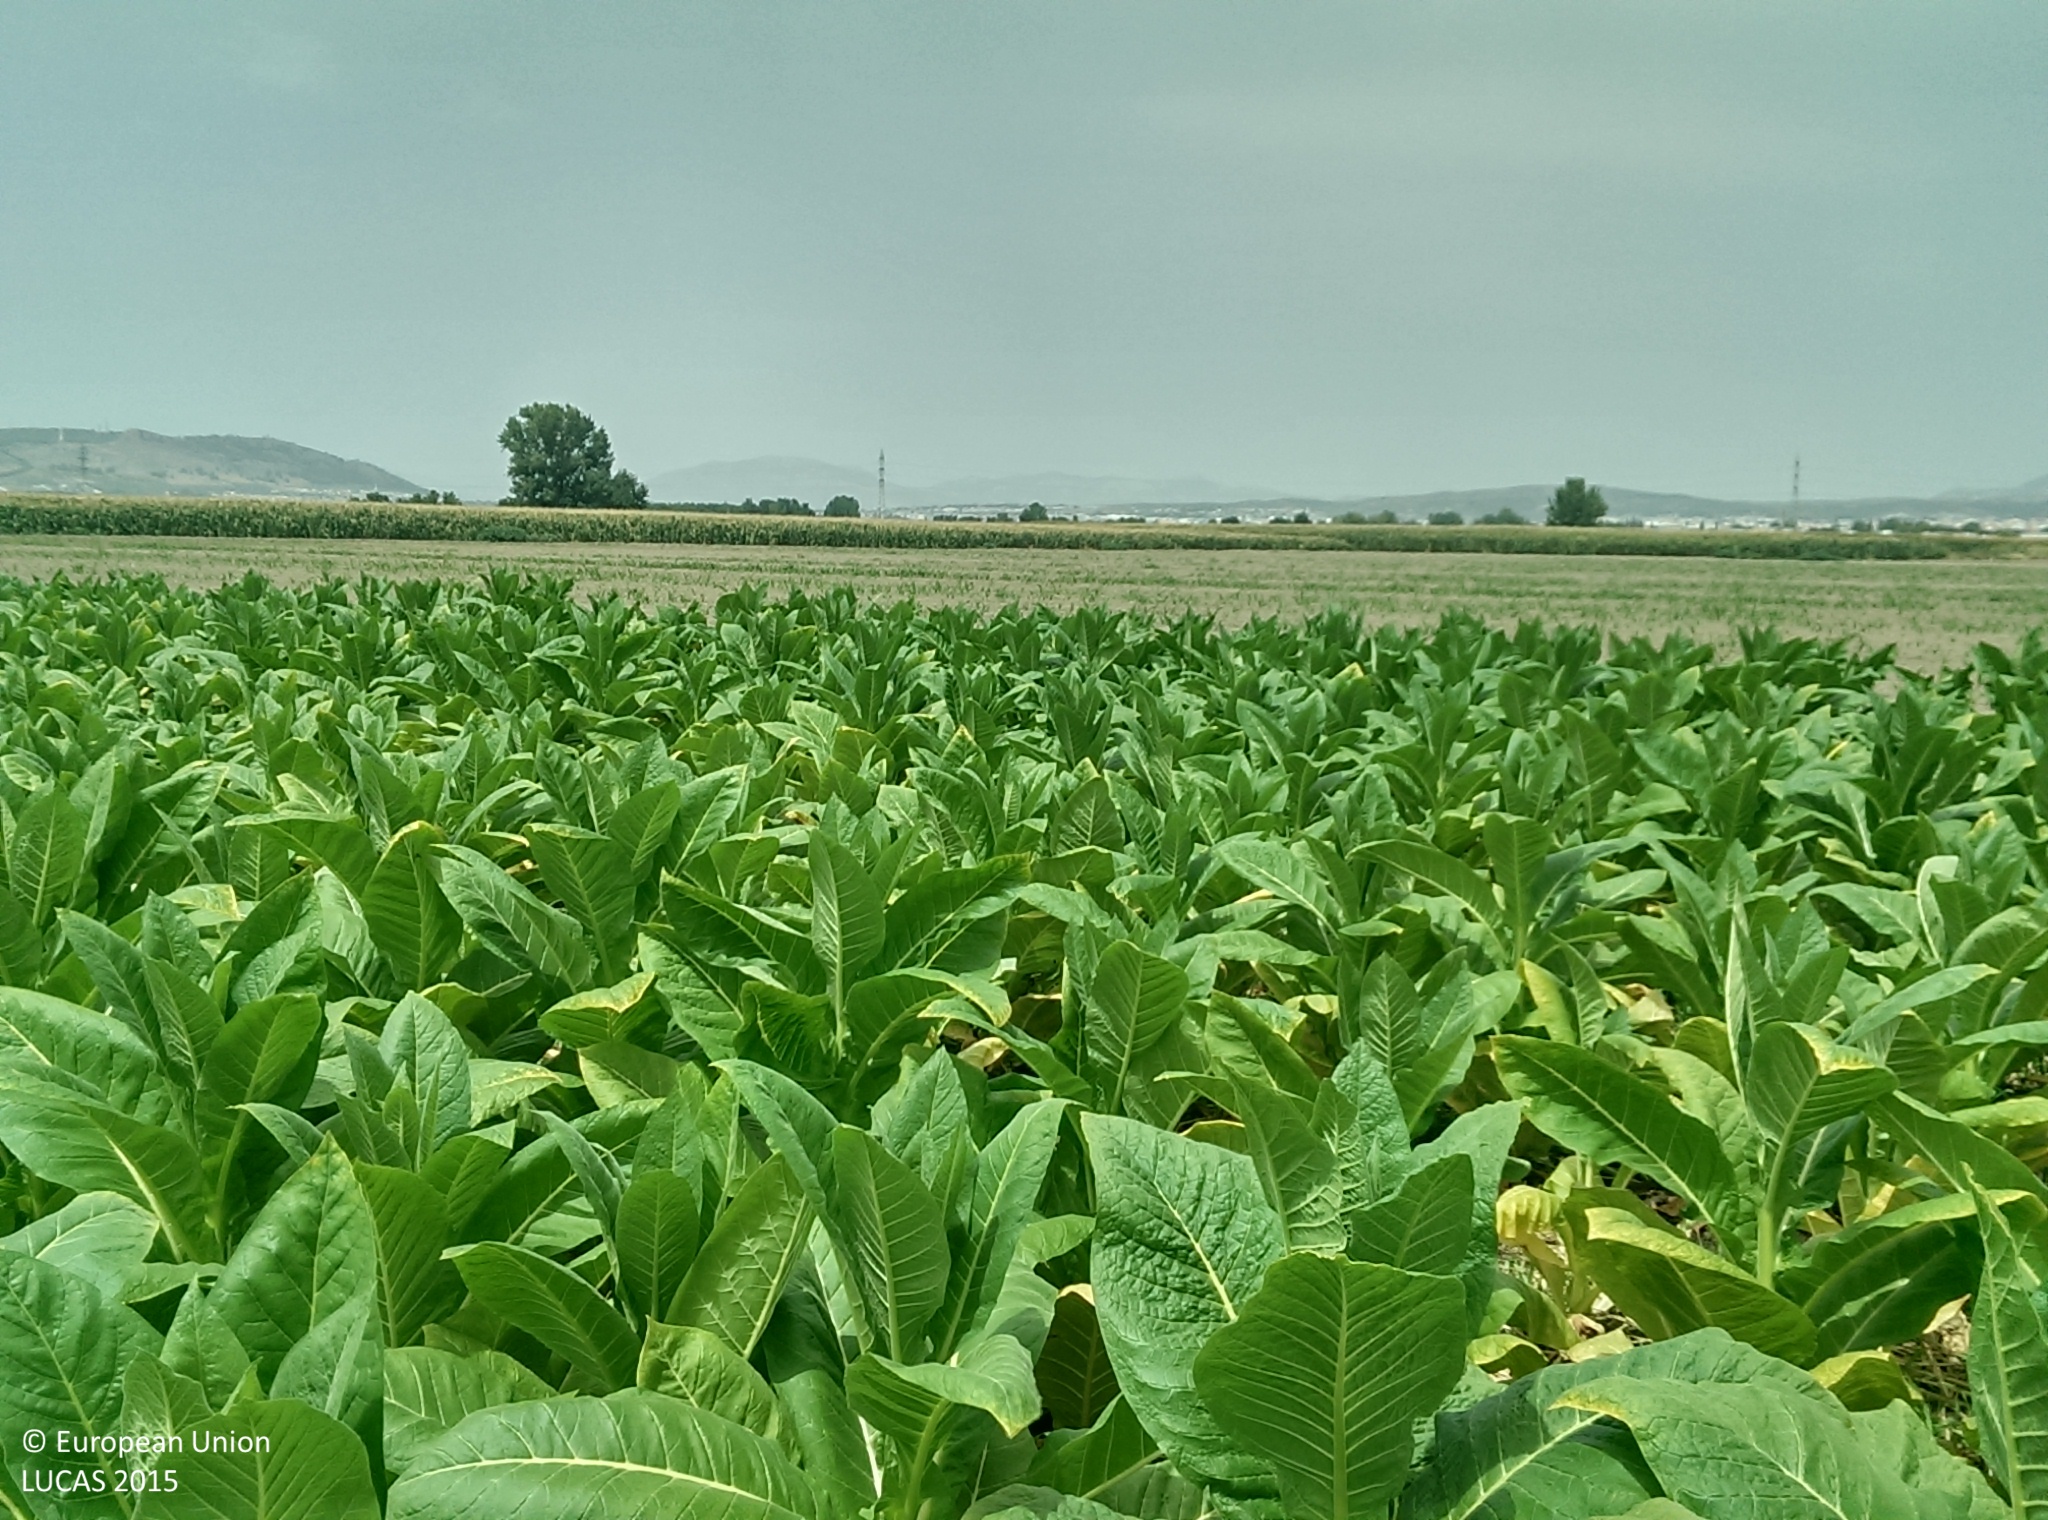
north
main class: Cropland
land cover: Tobacco
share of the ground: > 75 %
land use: Agriculture (excluding fallow land and kitchen gardens)
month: August
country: ES
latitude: 37.1803
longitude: -3.6526
